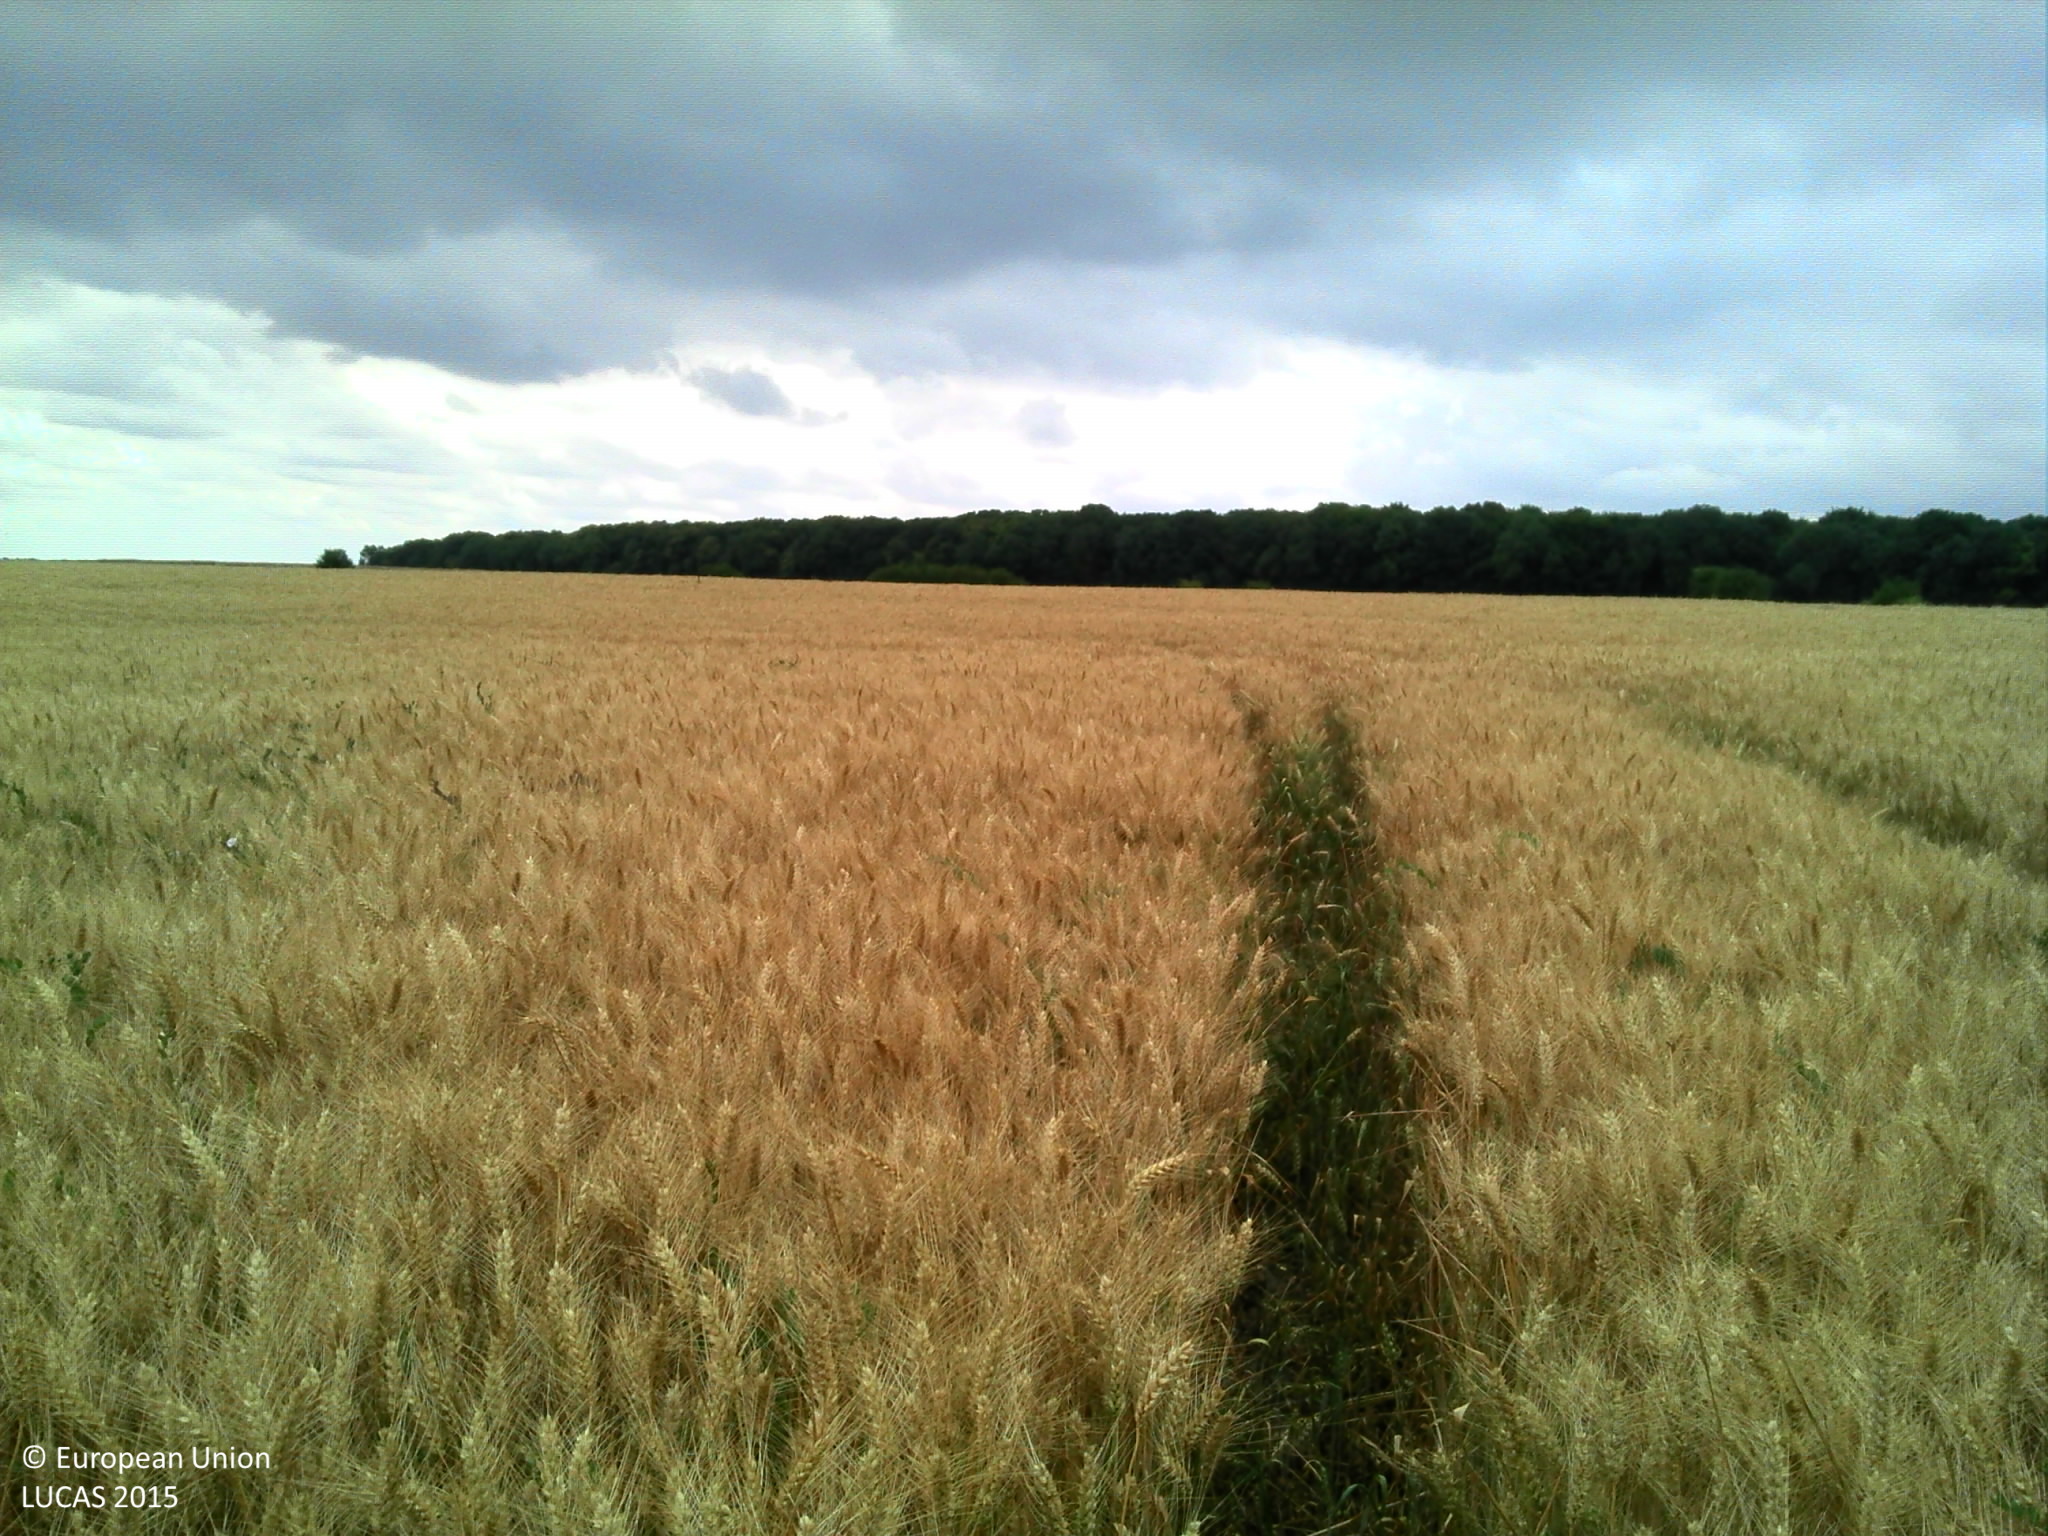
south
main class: Cropland
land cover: Common wheat
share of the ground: > 75 %
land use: Agriculture (excluding fallow land and kitchen gardens)
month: July
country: FR
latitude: 49.8388
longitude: 2.3812
